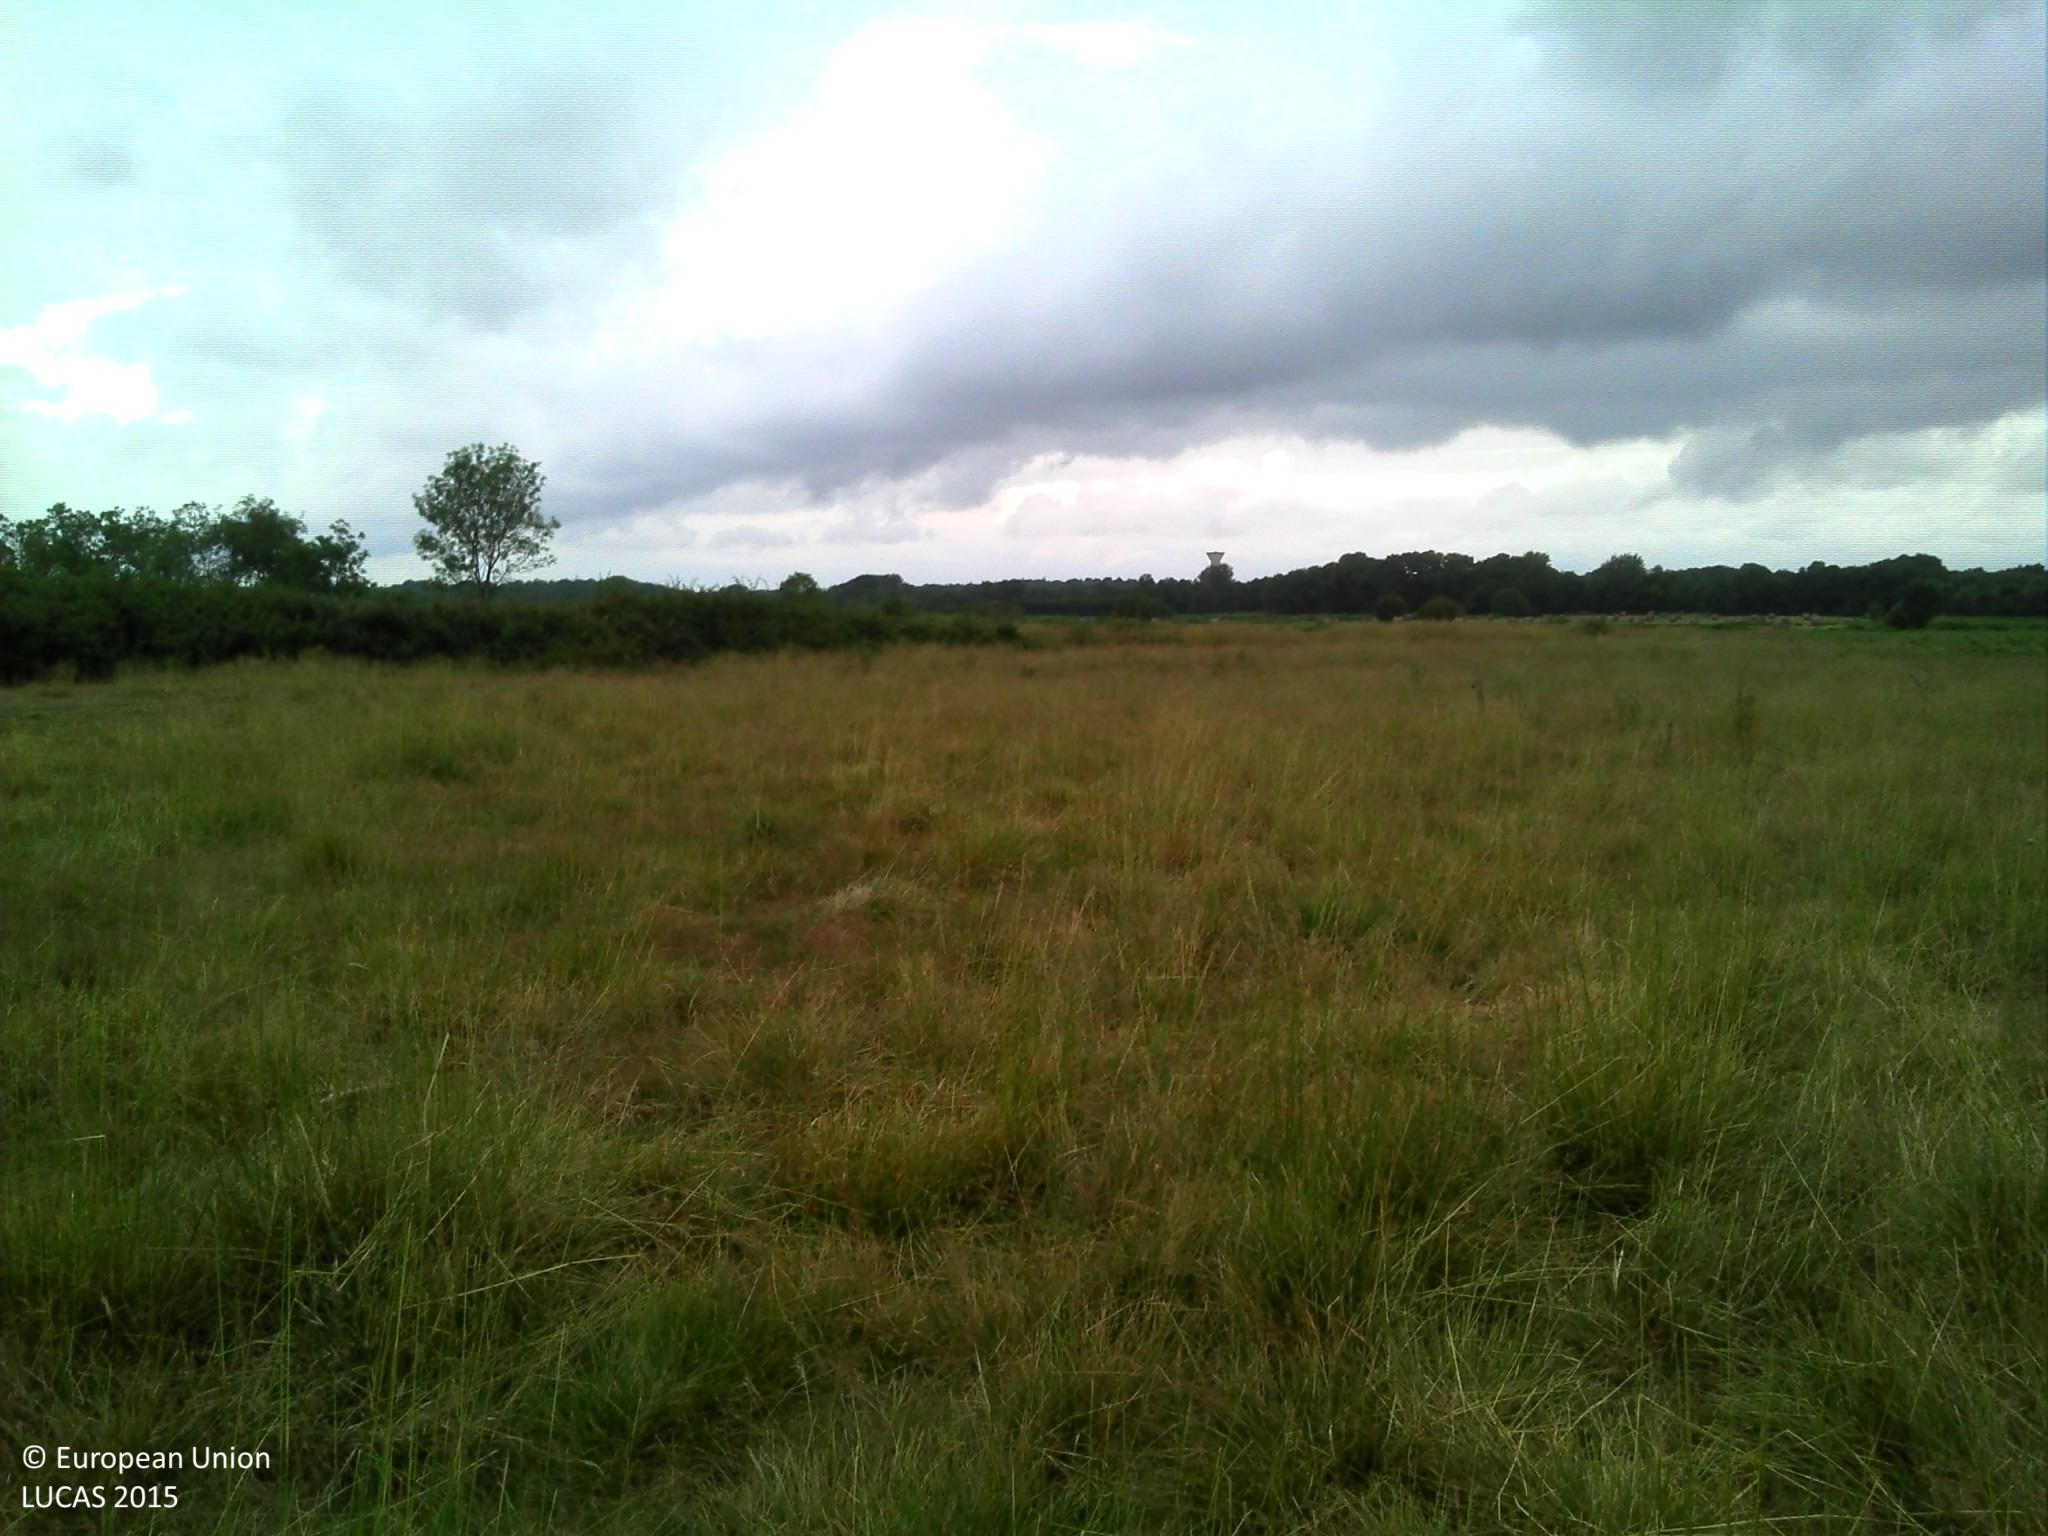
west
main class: Grassland
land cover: Grassland without tree/shrub cover
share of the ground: > 75 %
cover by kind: herbaceous plants 100 %
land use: Agriculture (excluding fallow land and kitchen gardens)
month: July
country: FR
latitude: 47.1009
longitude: -1.7576
